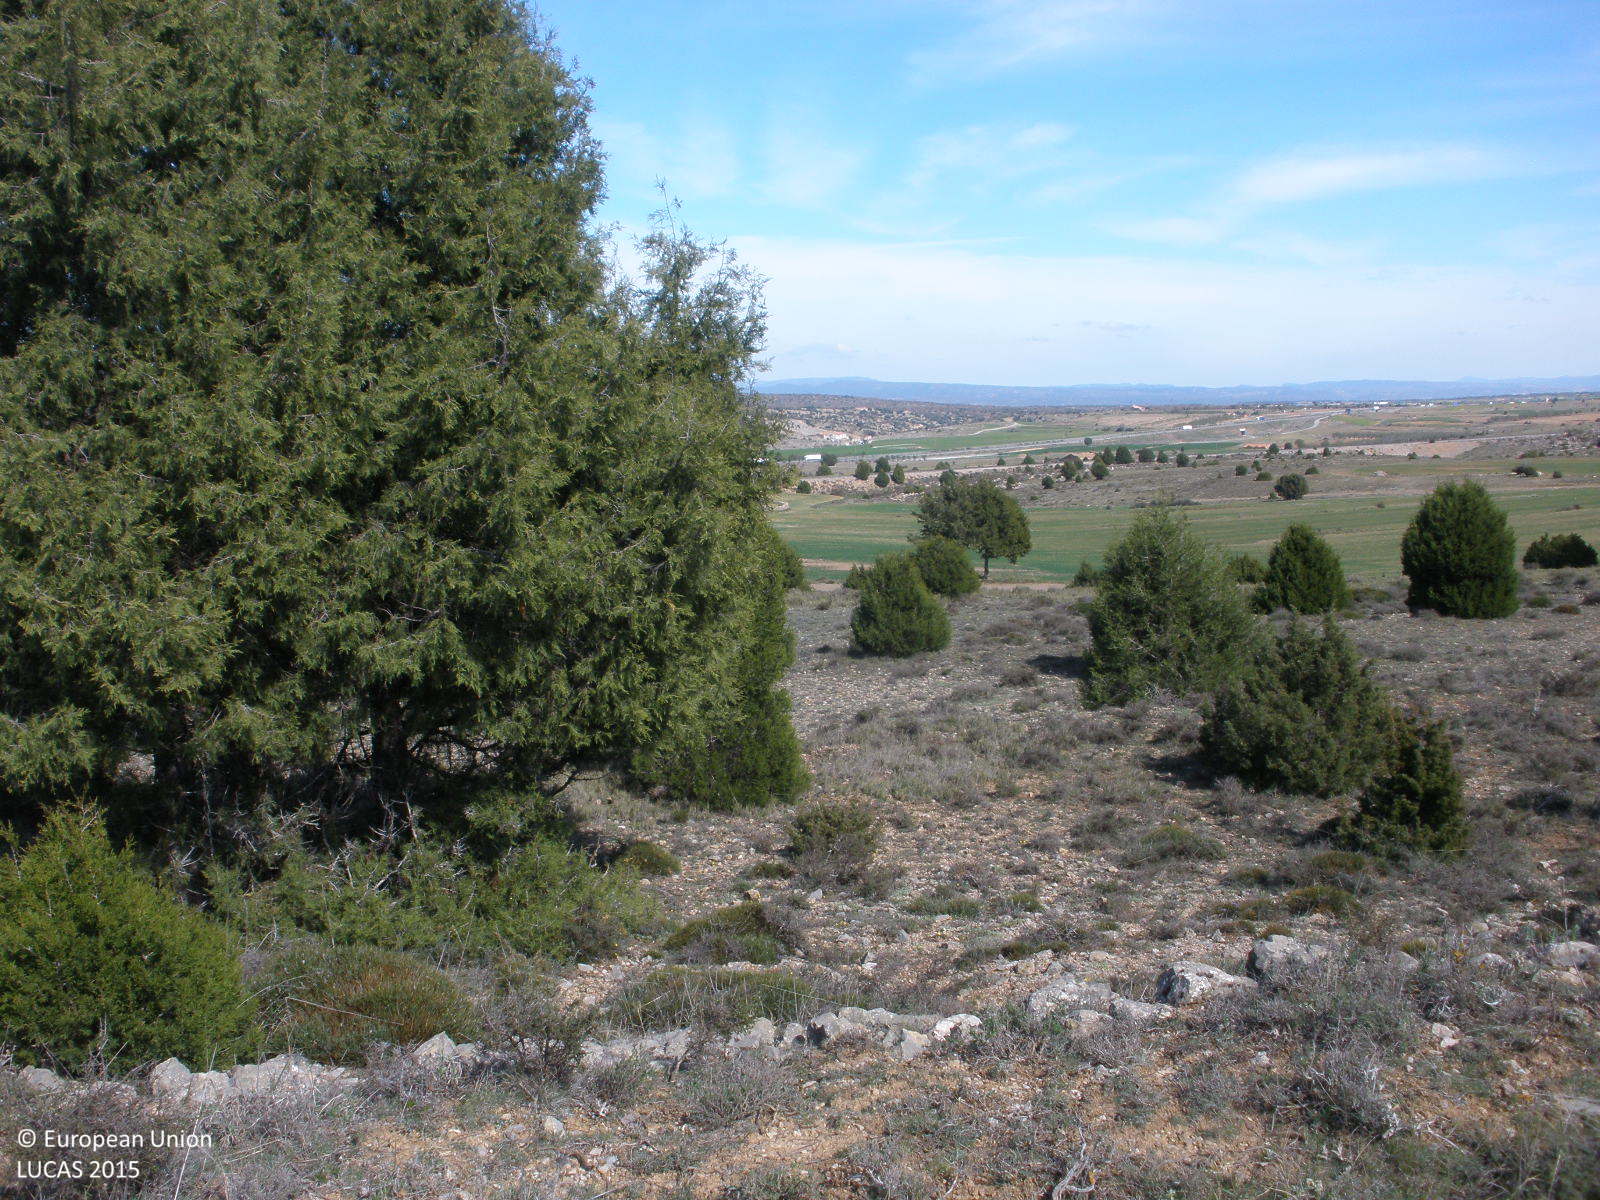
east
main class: Shrubland
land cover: Shrubland with sparse tree cover
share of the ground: 25 - 50 %
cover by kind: shrubs 40 %, consolidated bare surface 30 %, herbaceous plants 25 %, coniferous forest trees 5 %
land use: Agriculture (excluding fallow land and kitchen gardens)
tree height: < 5 m
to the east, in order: Shrubland with sparse tree cover; Tracks; Shrubland without tree cover; Shrubland with sparse tree cover; Shrubland without tree cover
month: April
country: ES
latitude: 40.2514
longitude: -0.9776
